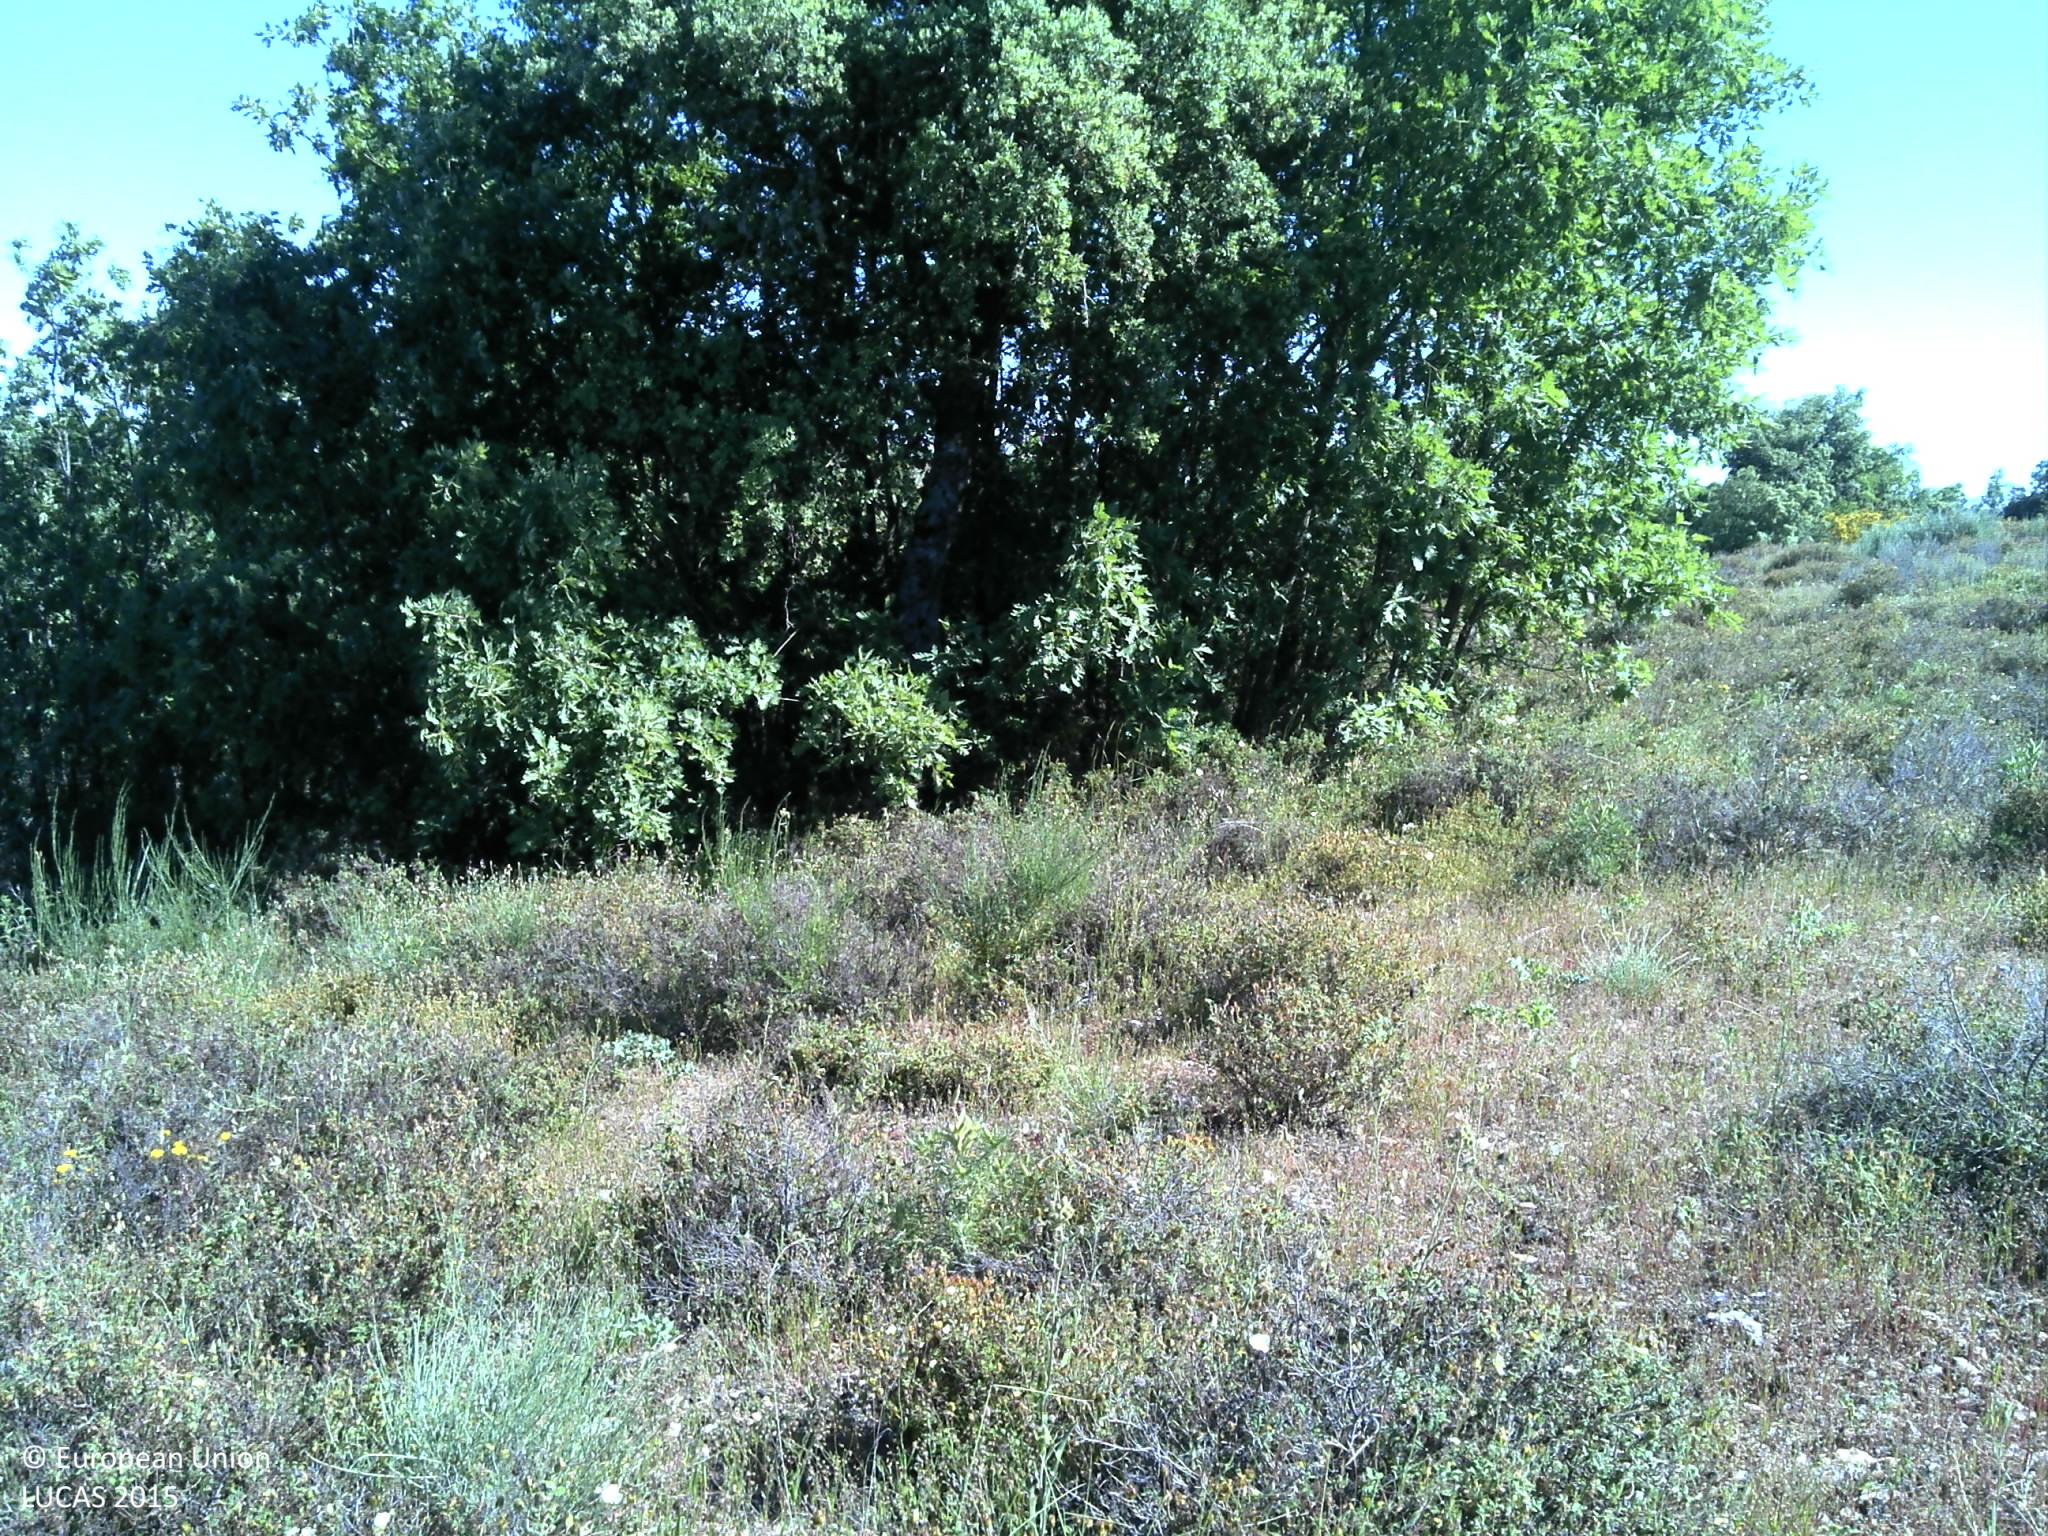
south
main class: Shrubland
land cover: Shrubland without tree cover
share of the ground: 25 - 50 %
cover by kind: shrubs 50 %, unconsolidated bare surface 30 %, herbaceous plants 20 %
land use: Abandoned areas
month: May
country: PT
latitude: 41.4980
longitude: -6.3551
